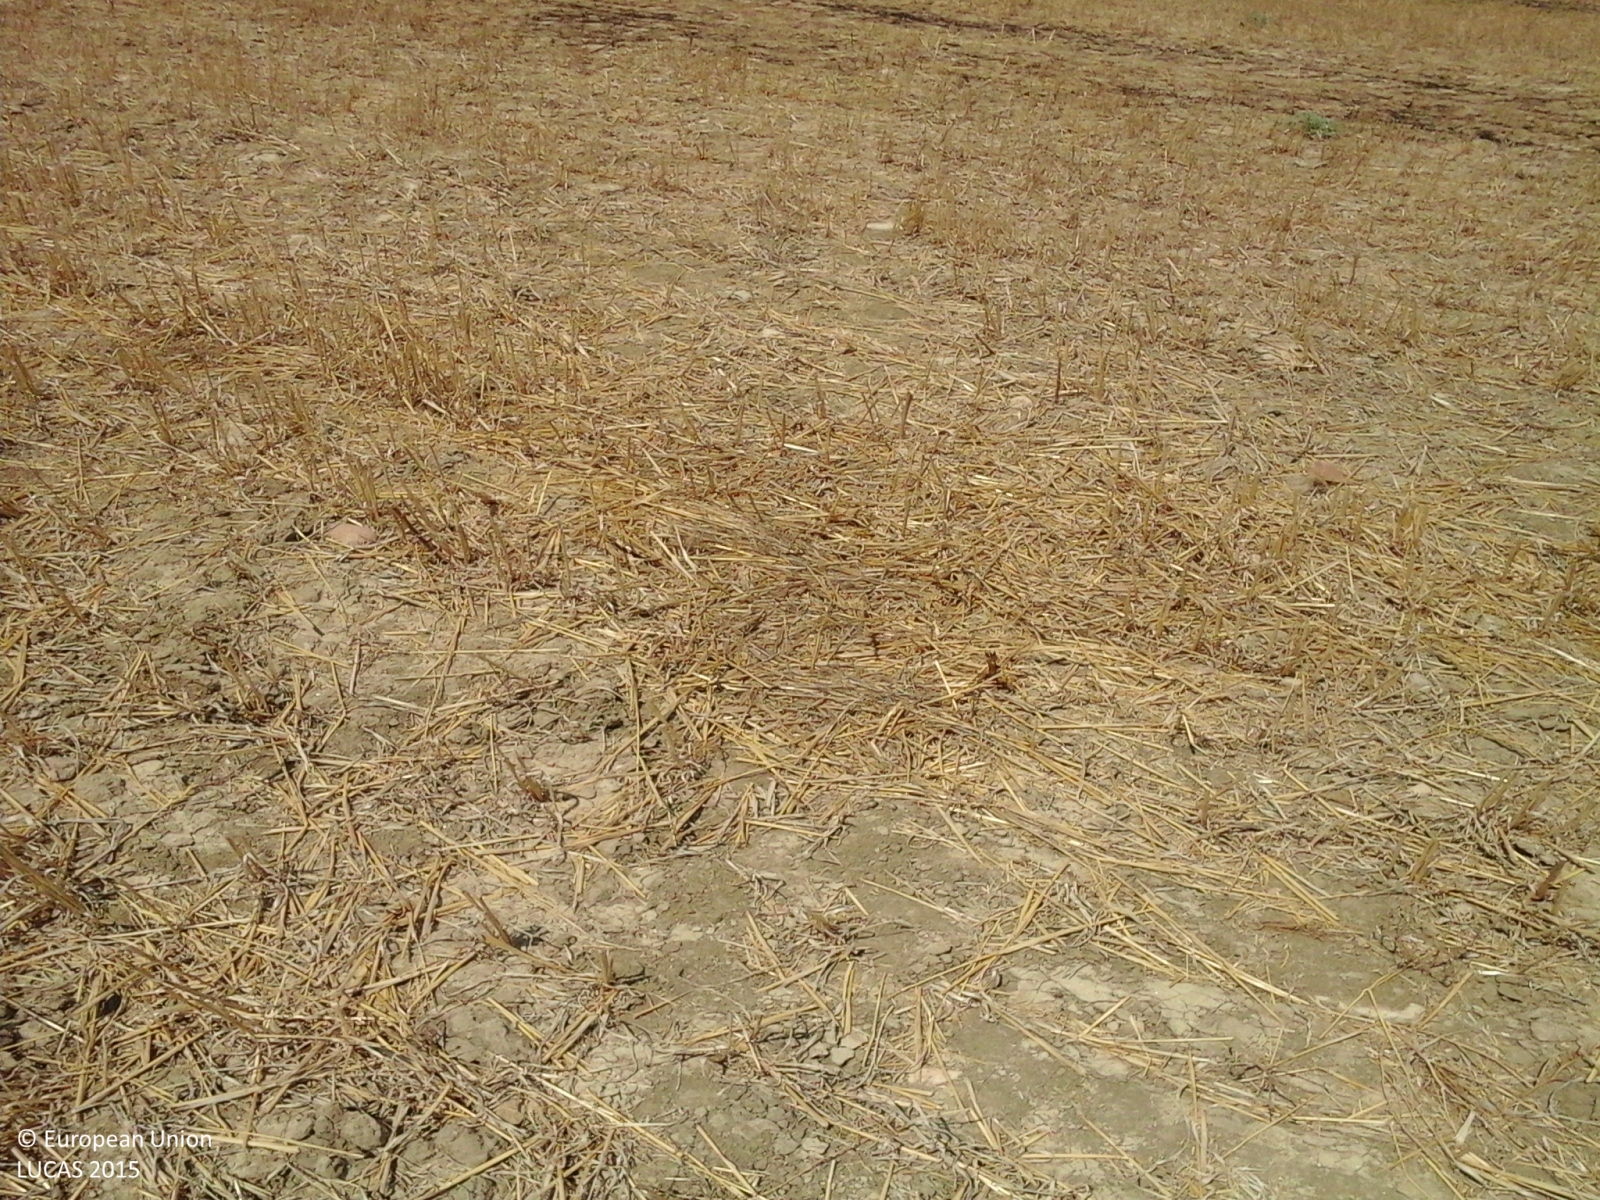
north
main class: Cropland
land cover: Durum wheat
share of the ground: > 75 %
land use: Agriculture (excluding fallow land and kitchen gardens)
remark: Burnt area
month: July
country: IT
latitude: 37.1562
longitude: 14.3687
